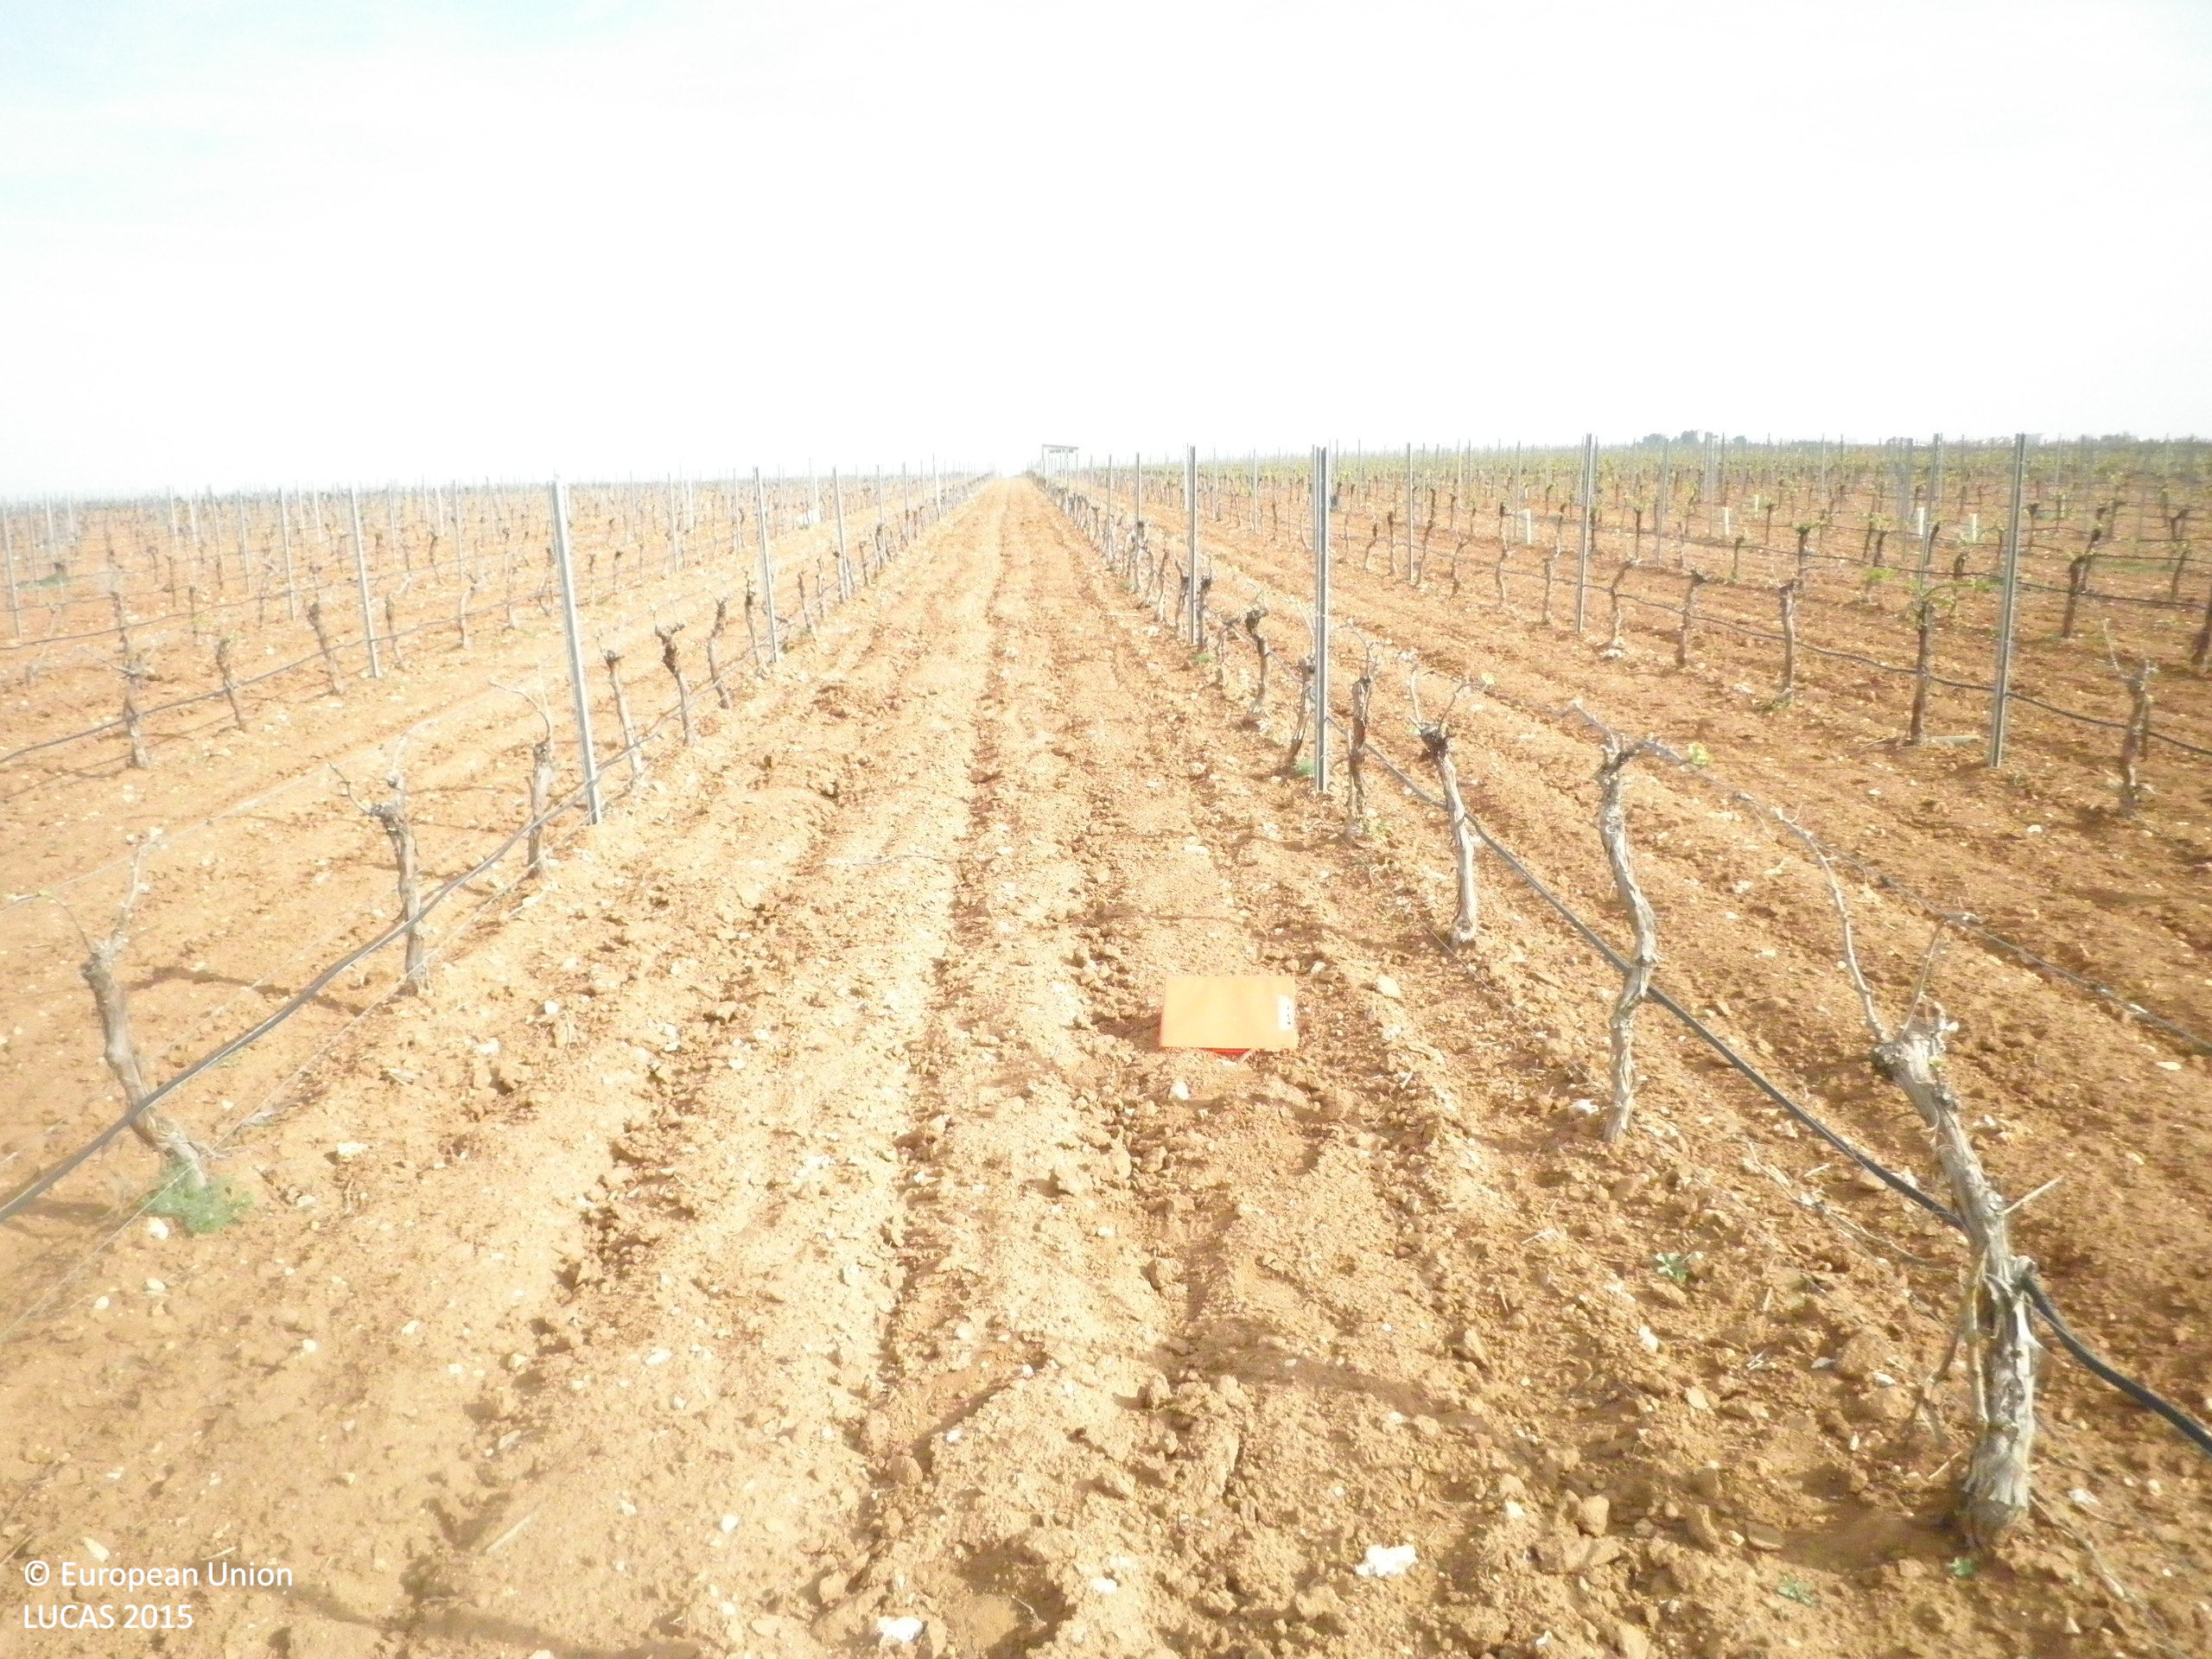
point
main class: Cropland
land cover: Vineyards
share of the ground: < 10 %
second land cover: Other bare soil
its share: > 75 %
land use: Agriculture (excluding fallow land and kitchen gardens)
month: April
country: ES
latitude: 39.3742
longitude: -2.7703
